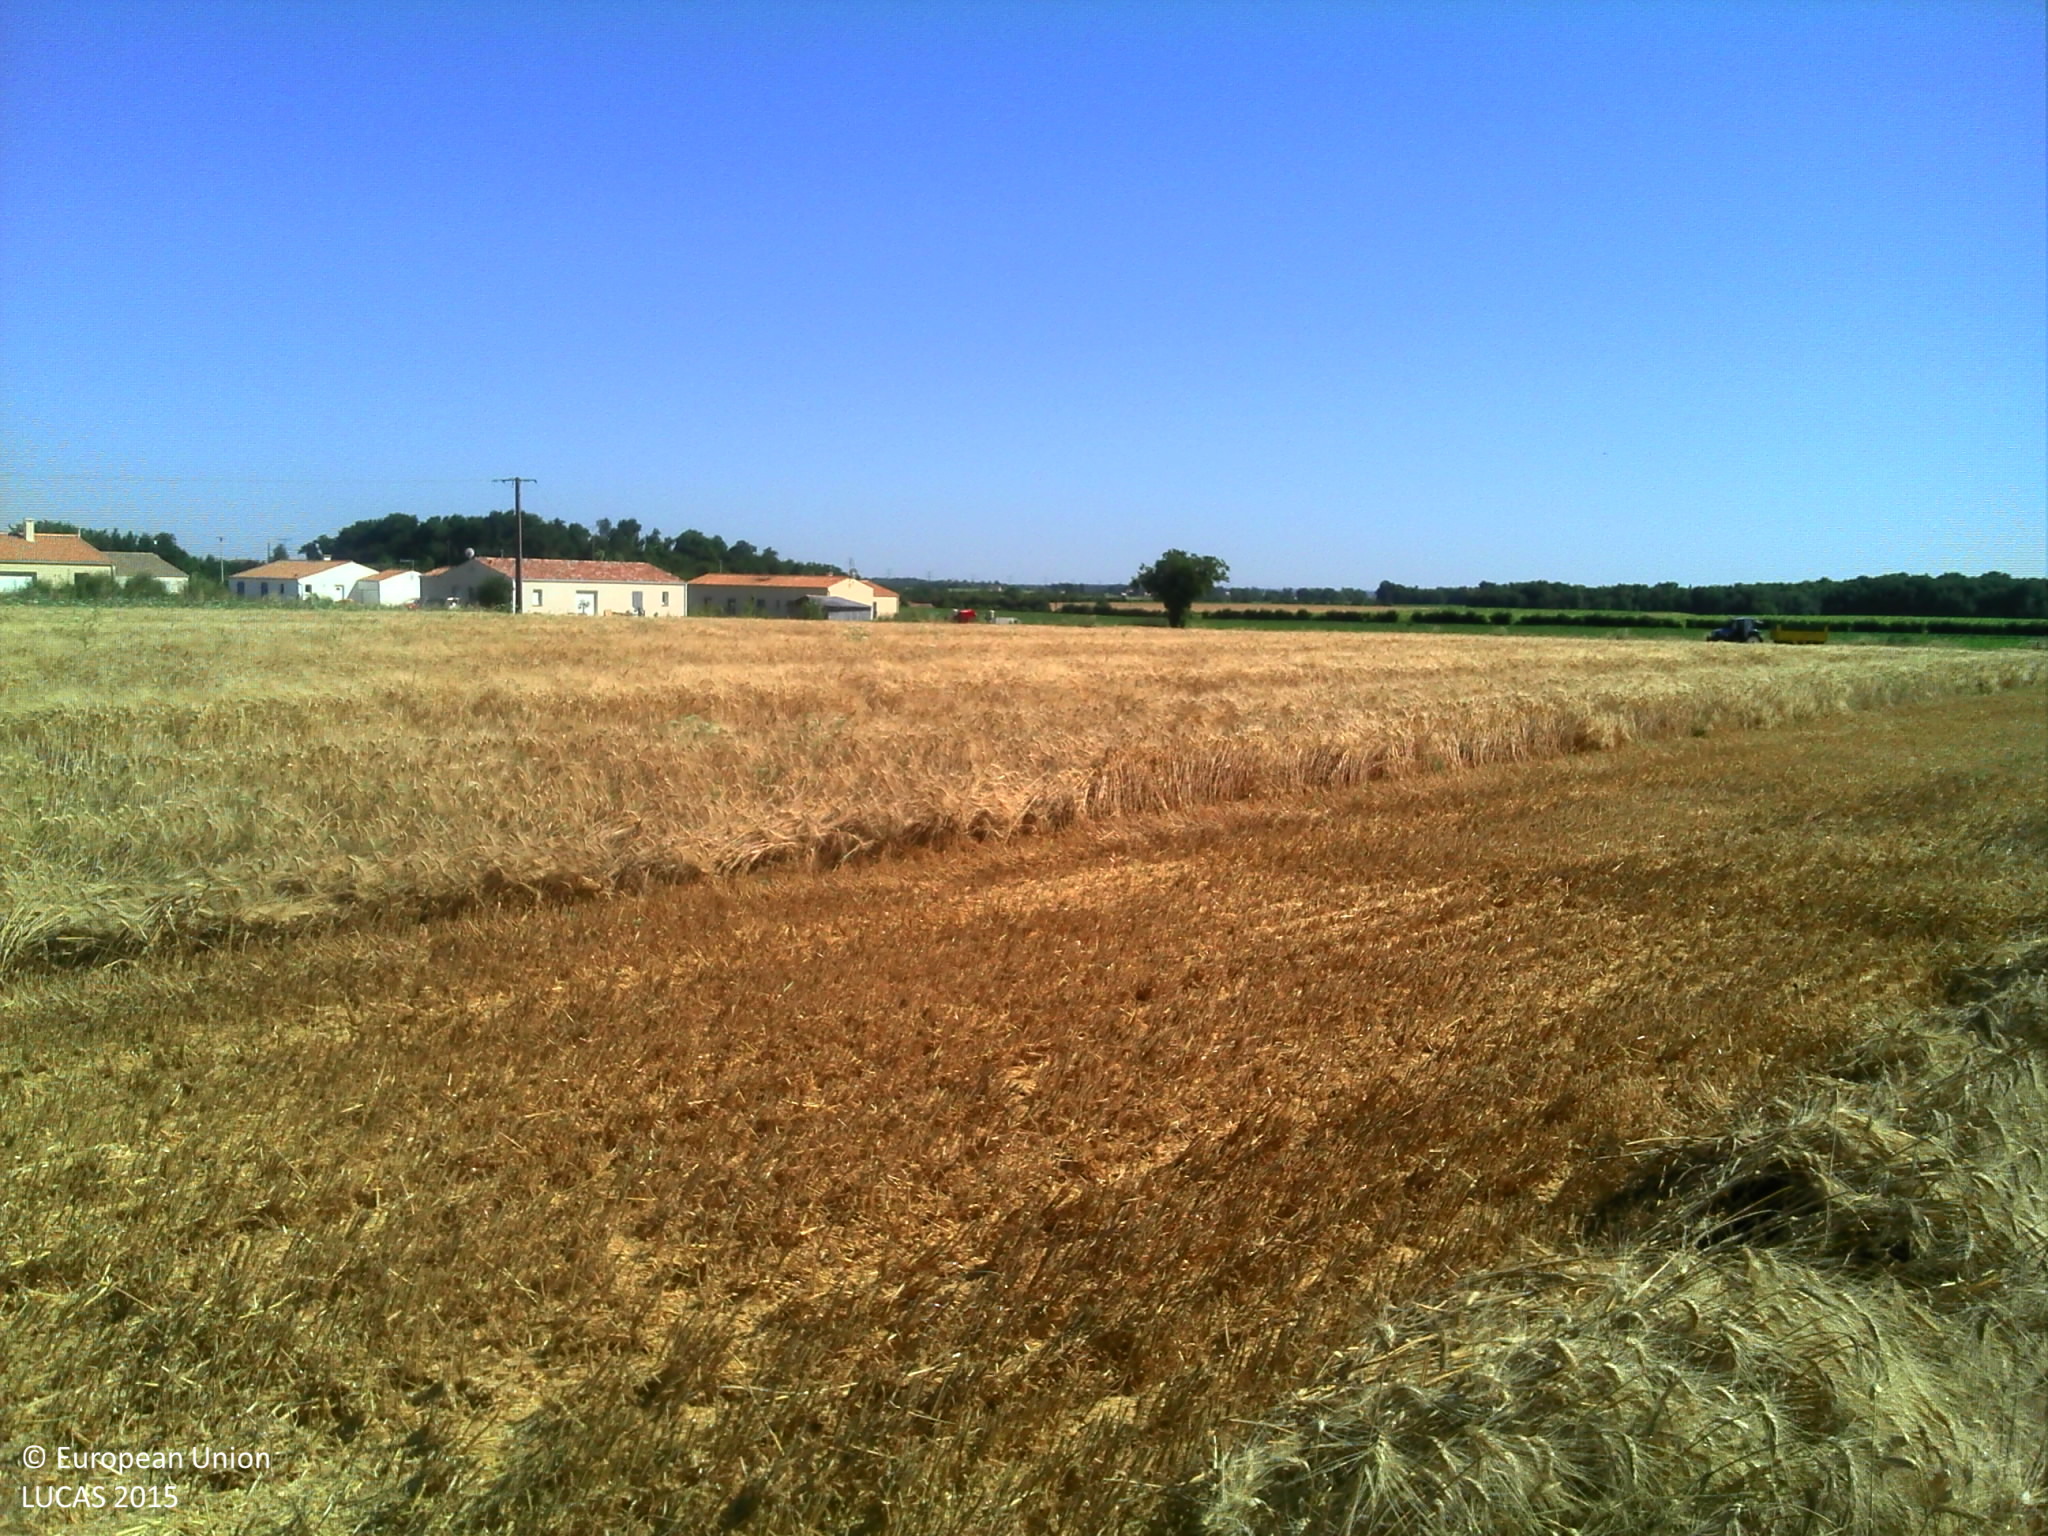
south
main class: Cropland
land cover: Common wheat
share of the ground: > 75 %
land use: Agriculture (excluding fallow land and kitchen gardens)
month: June
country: FR
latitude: 45.5846
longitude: -0.6227
